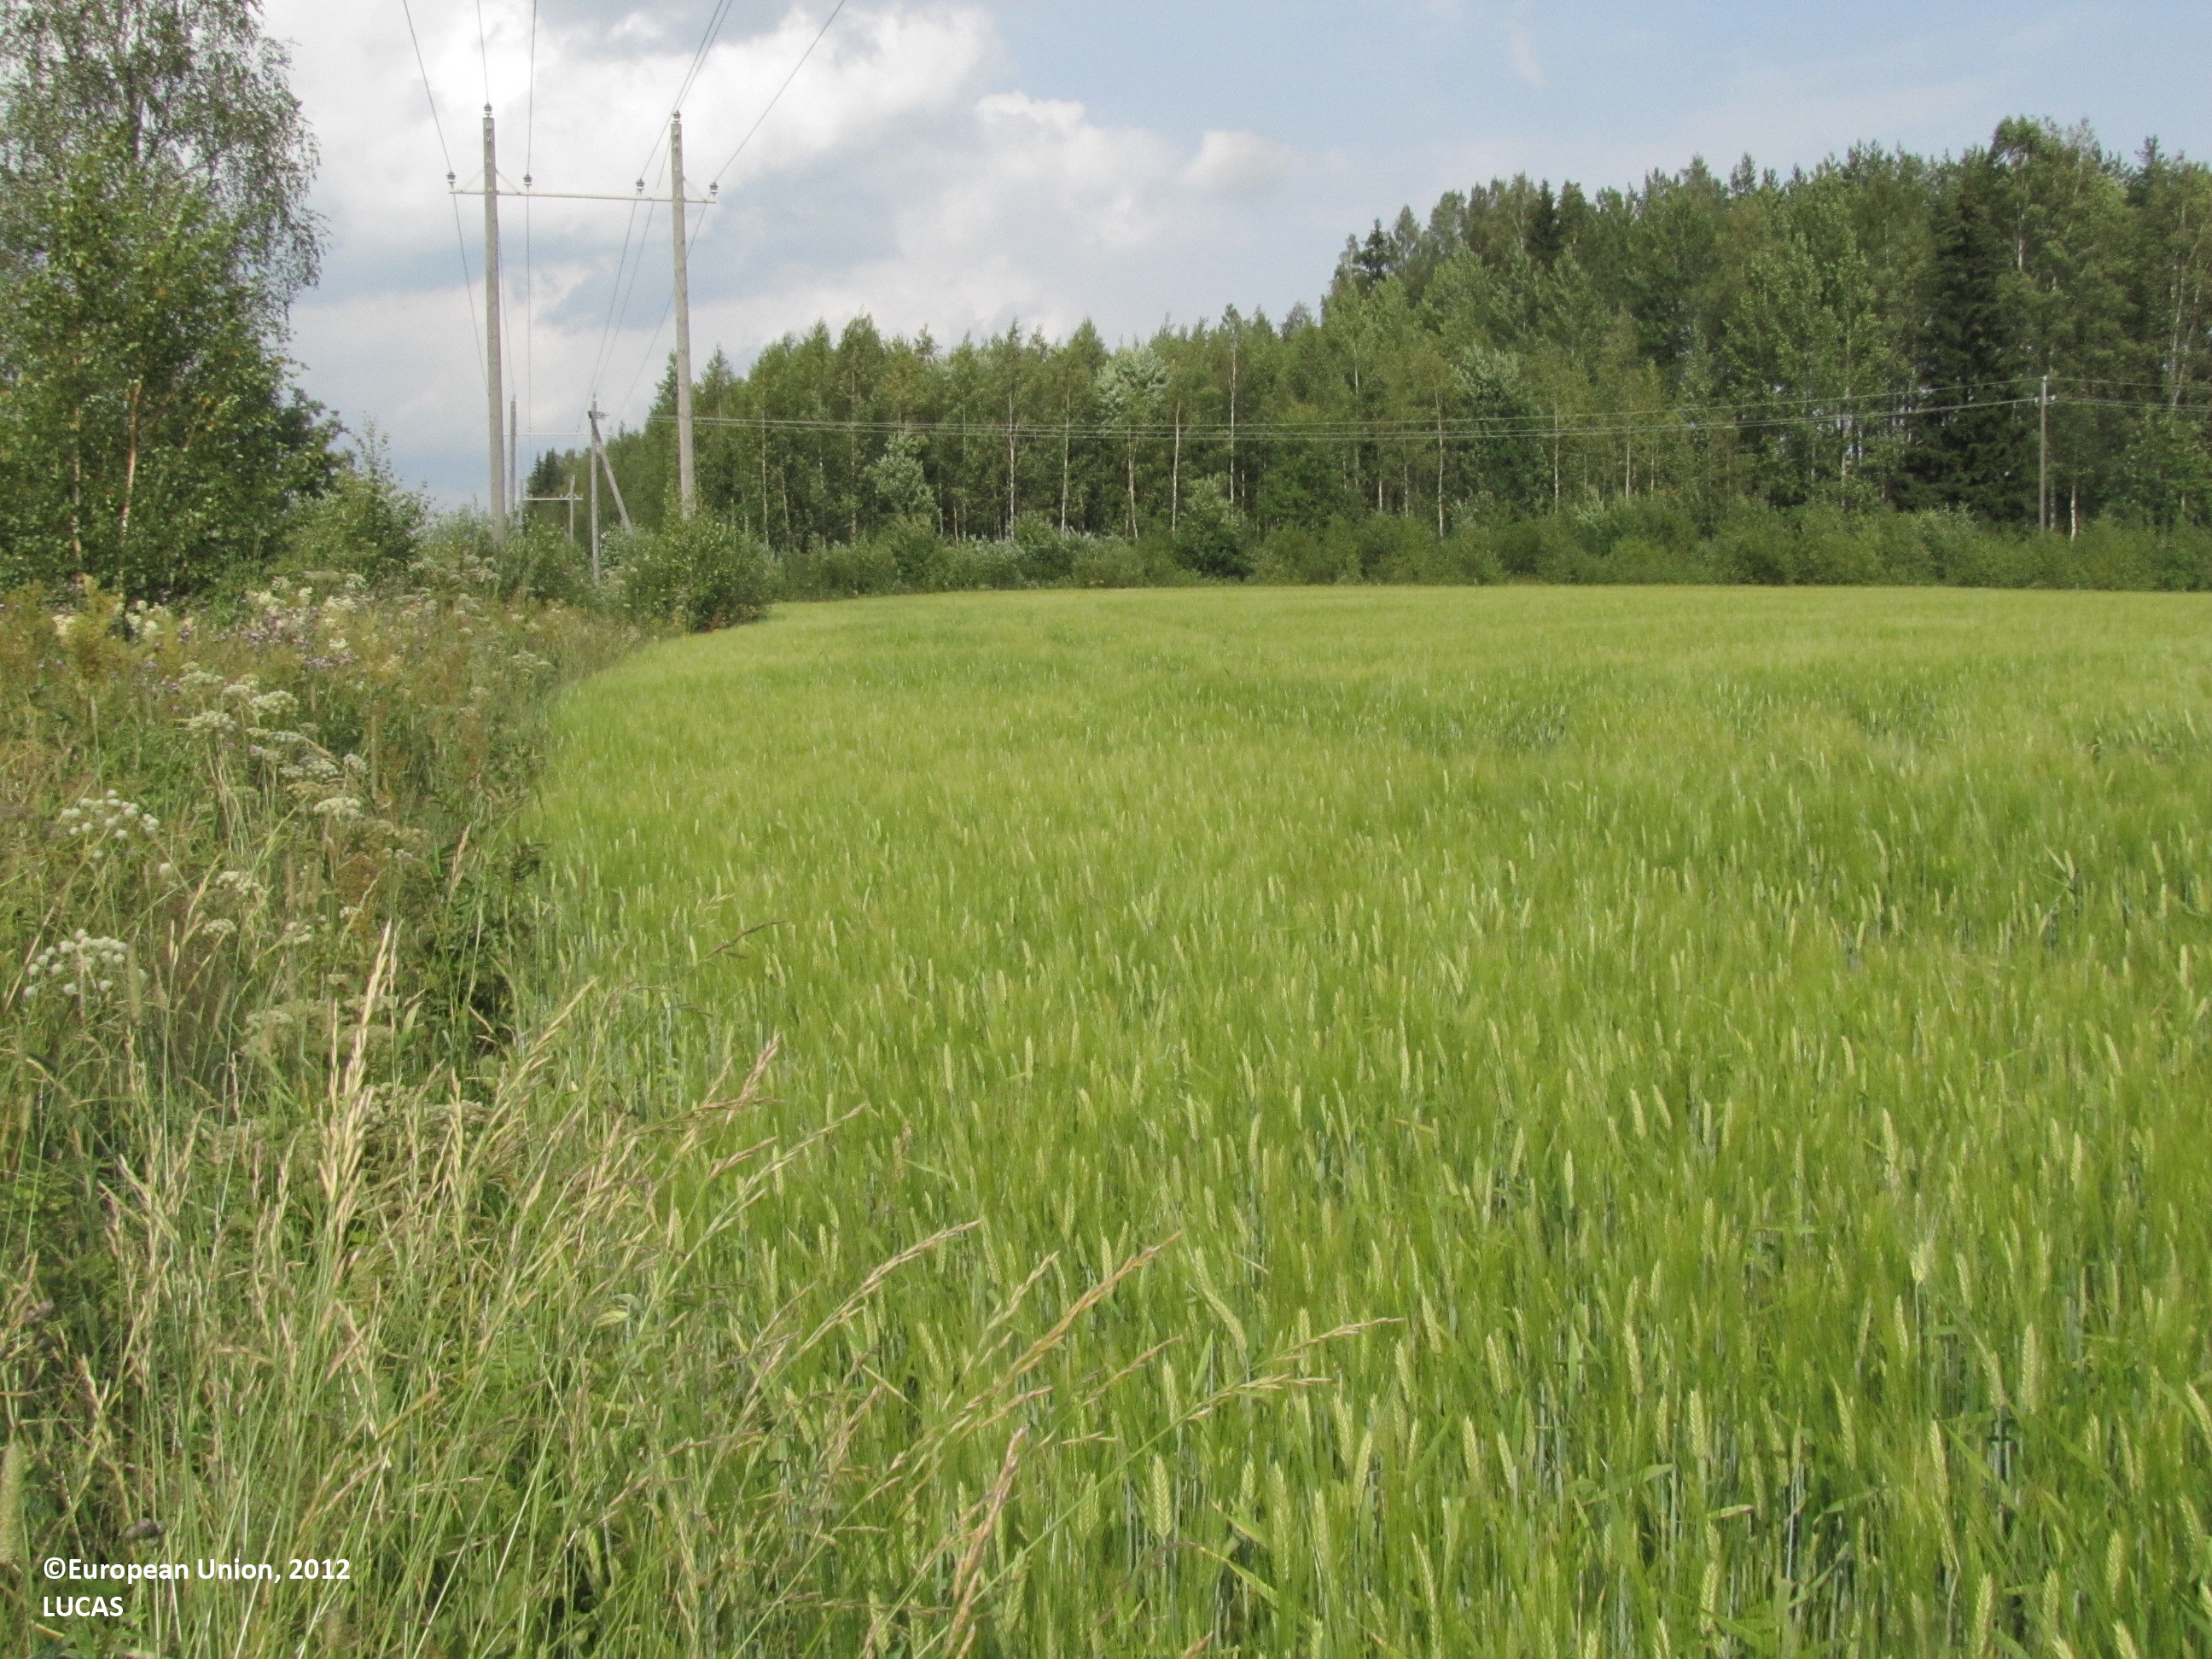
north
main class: Cropland
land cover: Temporary grasslands
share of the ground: > 75 %
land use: Agriculture (excluding fallow land and kitchen gardens)
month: July
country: FI
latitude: 62.0061
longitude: 23.0349
